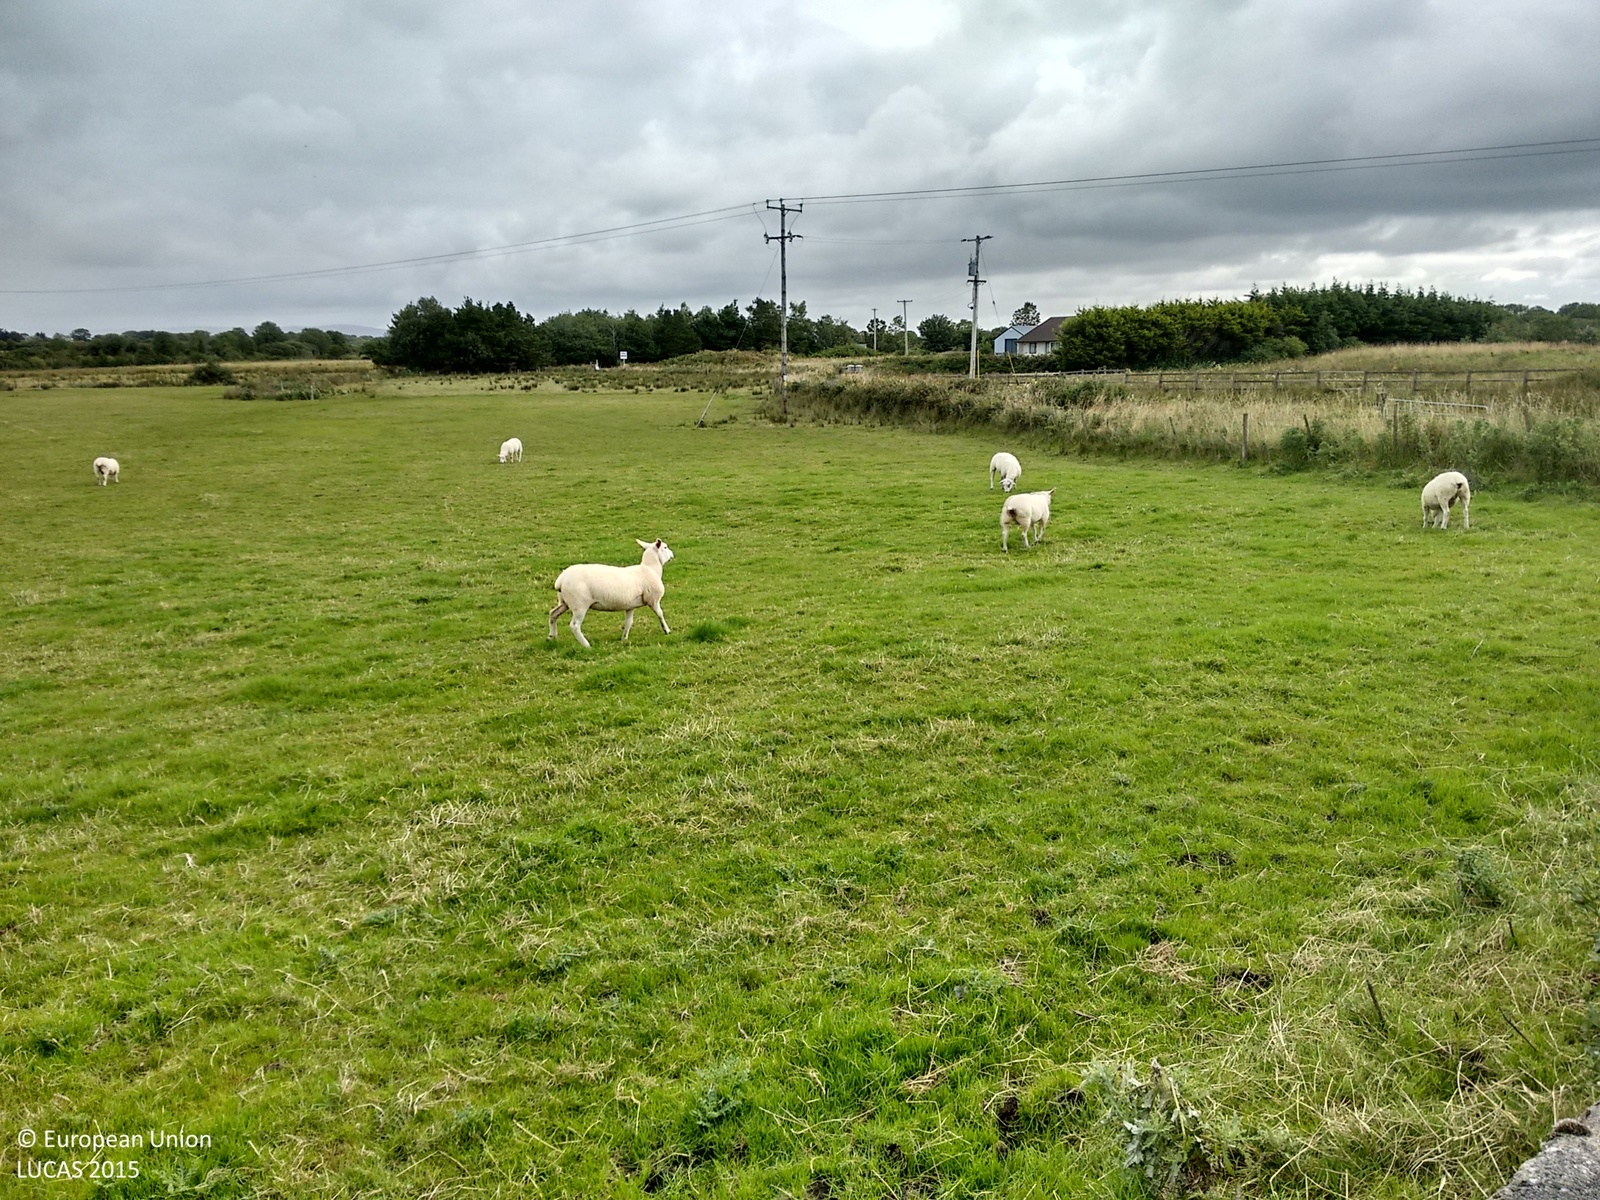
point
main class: Grassland
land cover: Grassland without tree/shrub cover
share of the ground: > 75 %
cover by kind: herbaceous plants 100 %
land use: Agriculture (excluding fallow land and kitchen gardens)
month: September
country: IE
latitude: 54.0943
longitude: -9.2580
